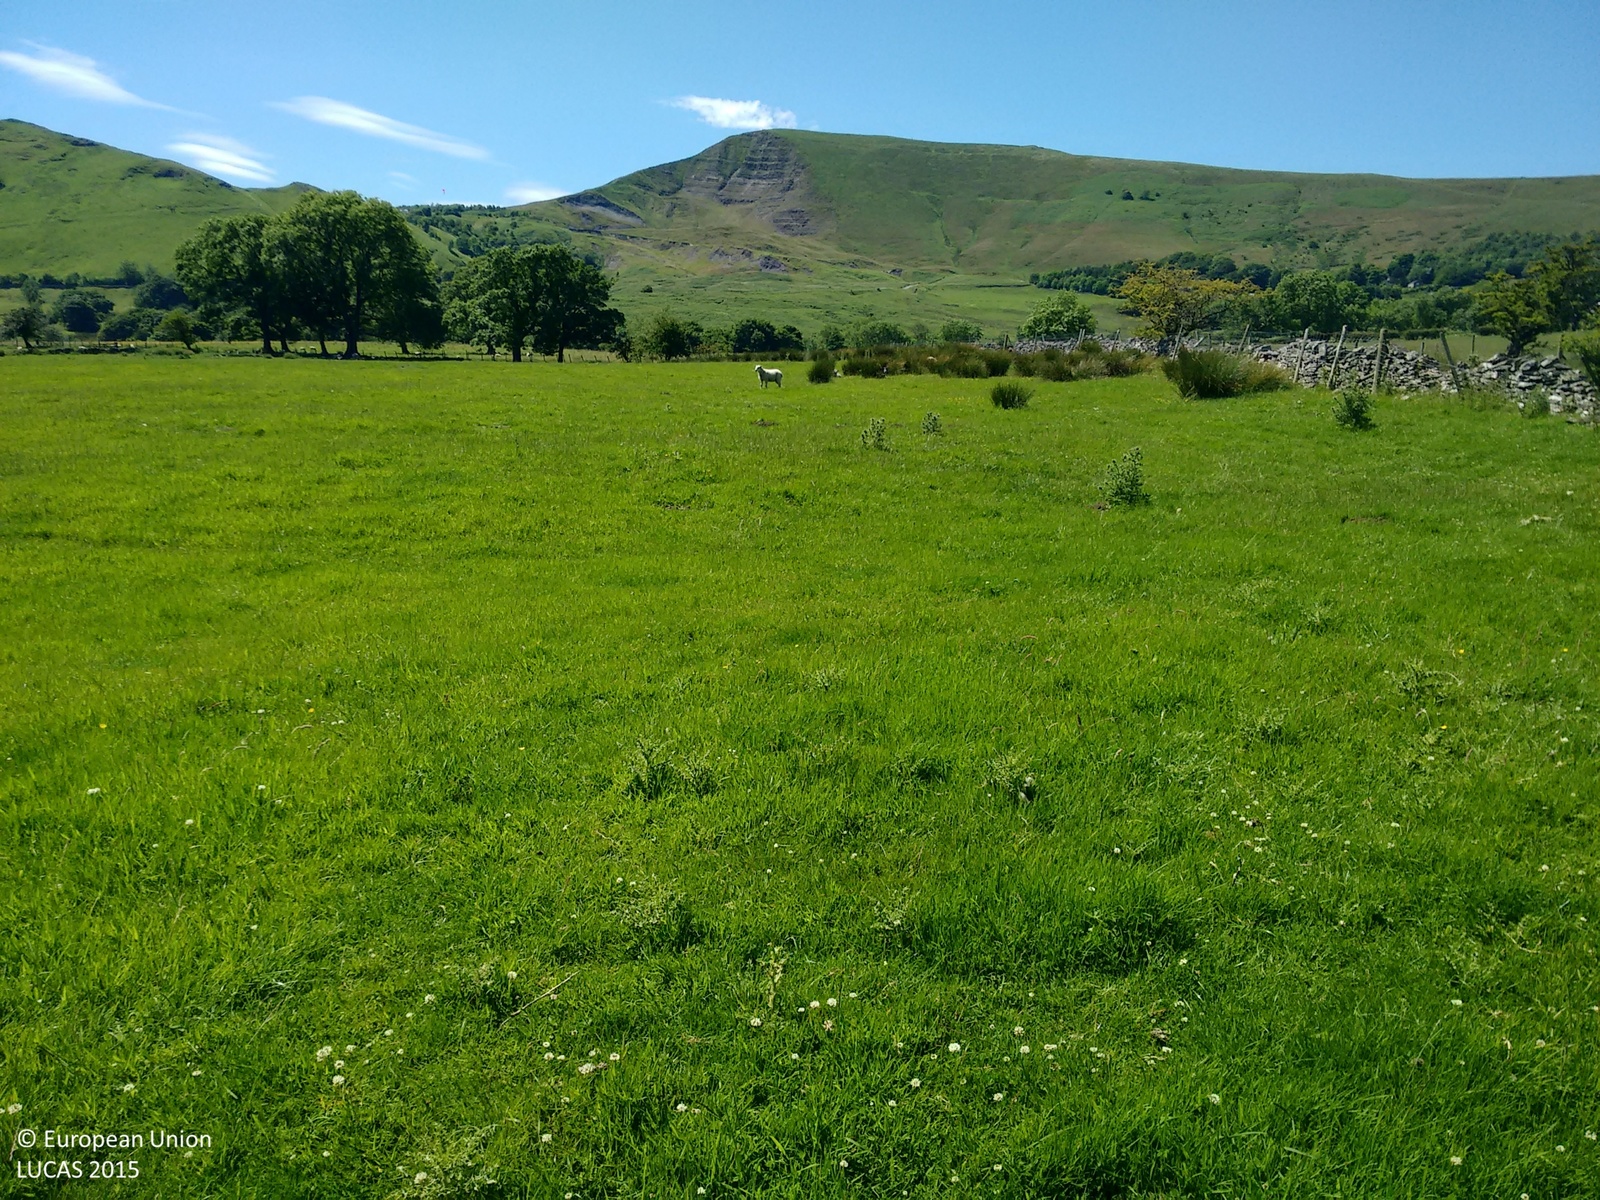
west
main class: Grassland
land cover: Grassland without tree/shrub cover
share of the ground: > 75 %
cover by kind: herbaceous plants 100 %
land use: Agriculture (excluding fallow land and kitchen gardens)
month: June
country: GB
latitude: 53.3510
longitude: -1.7872
